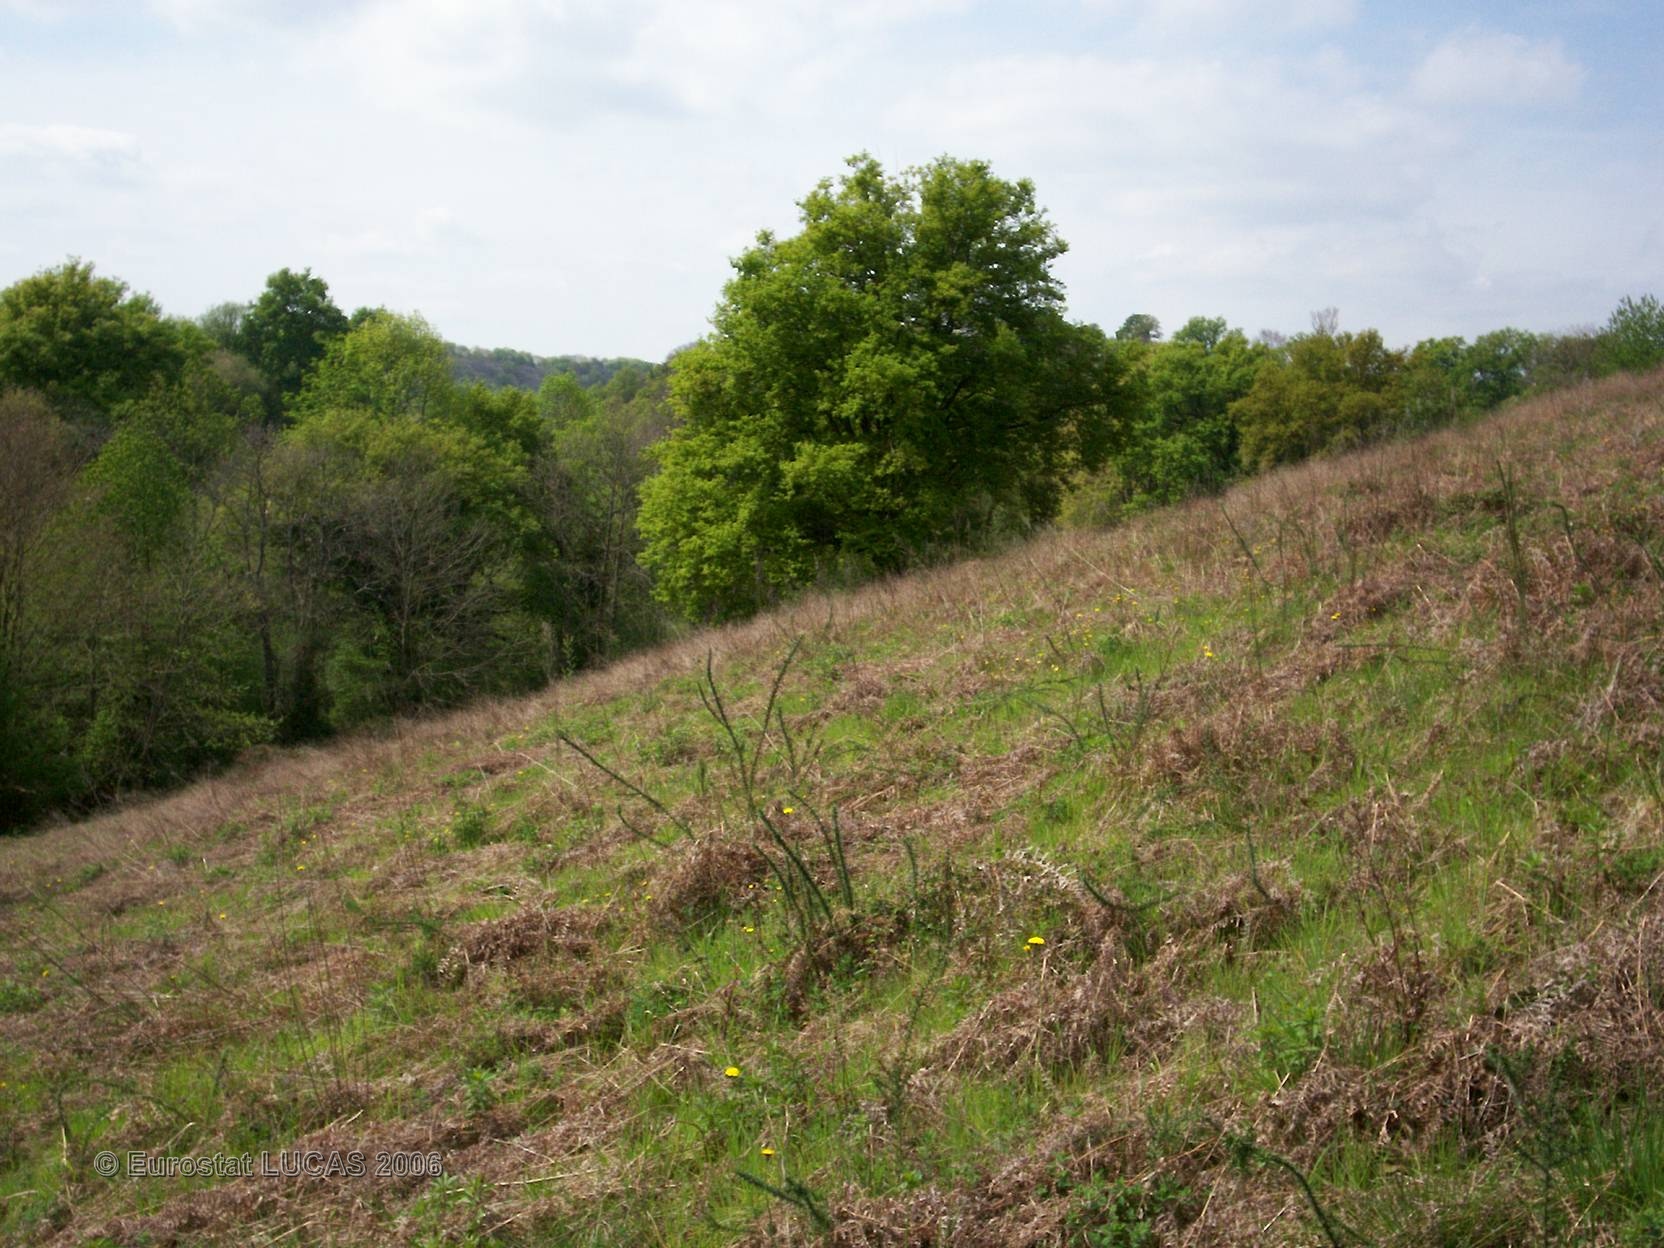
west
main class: Grassland
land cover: Grassland with sparse tree/shrub cover
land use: Fallow land
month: April
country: FR
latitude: 43.2591
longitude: -0.6148
